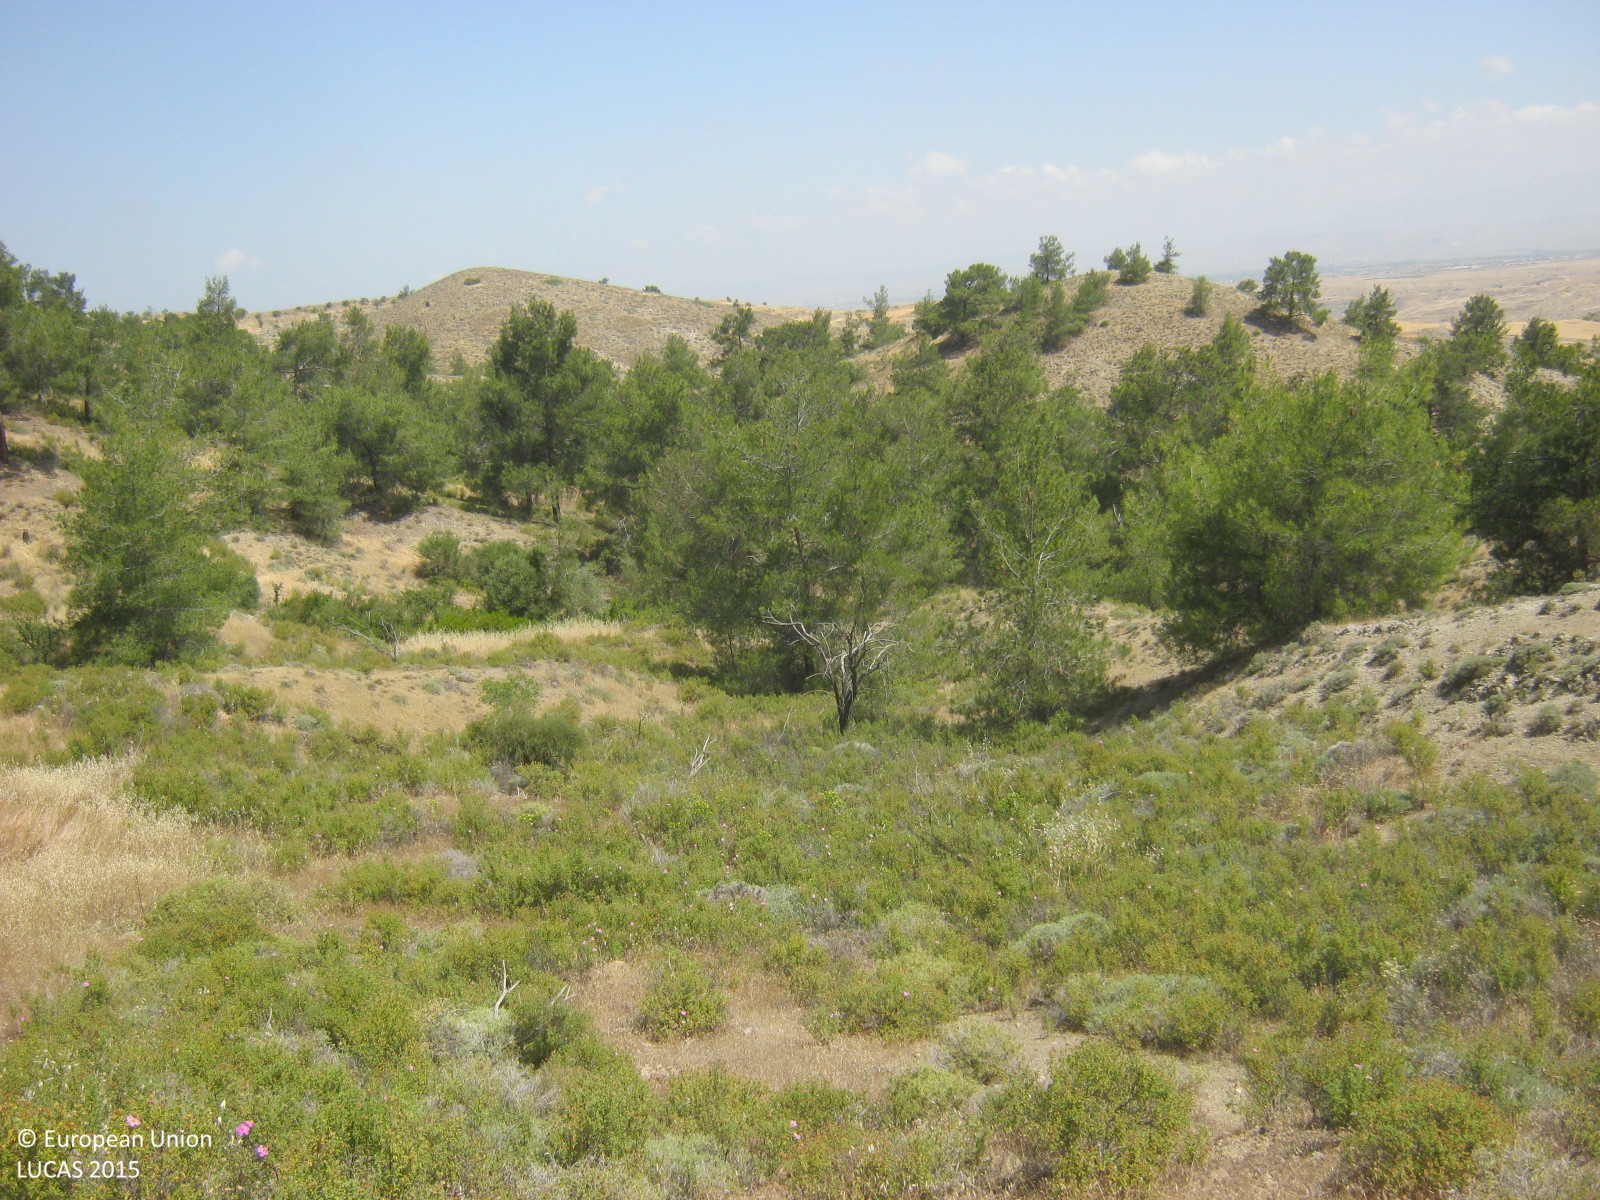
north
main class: Shrubland
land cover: Shrubland with sparse tree cover
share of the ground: 25 - 50 %
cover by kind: shrubs 65 %, unconsolidated bare surface 20 %, herbaceous plants 10 %, coniferous forest trees 5 %
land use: Forestry
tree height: > 5 m
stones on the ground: 25 - 50 %
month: May
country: CY
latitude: 35.0649
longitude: 33.0405
